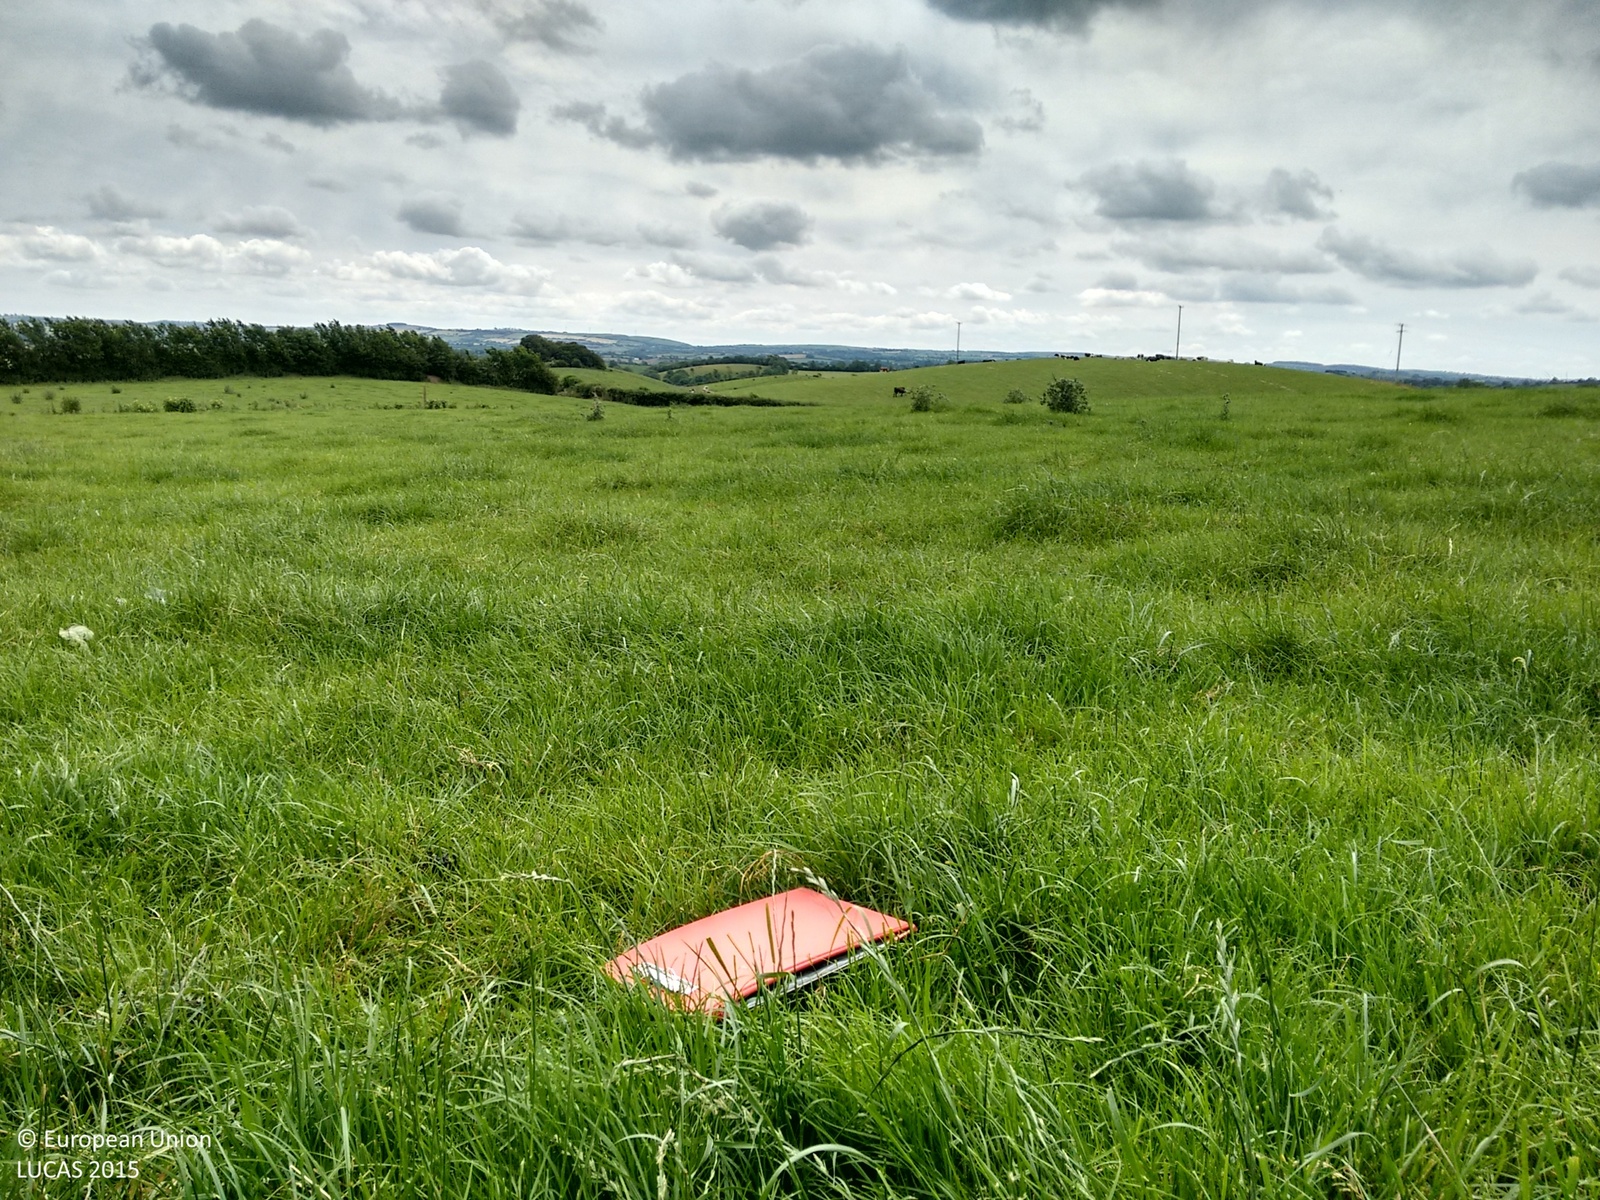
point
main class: Grassland
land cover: Grassland without tree/shrub cover
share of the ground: > 75 %
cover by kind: herbaceous plants 100 %
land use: Agriculture (excluding fallow land and kitchen gardens)
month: July
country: IE
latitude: 53.8719
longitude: -6.6629
